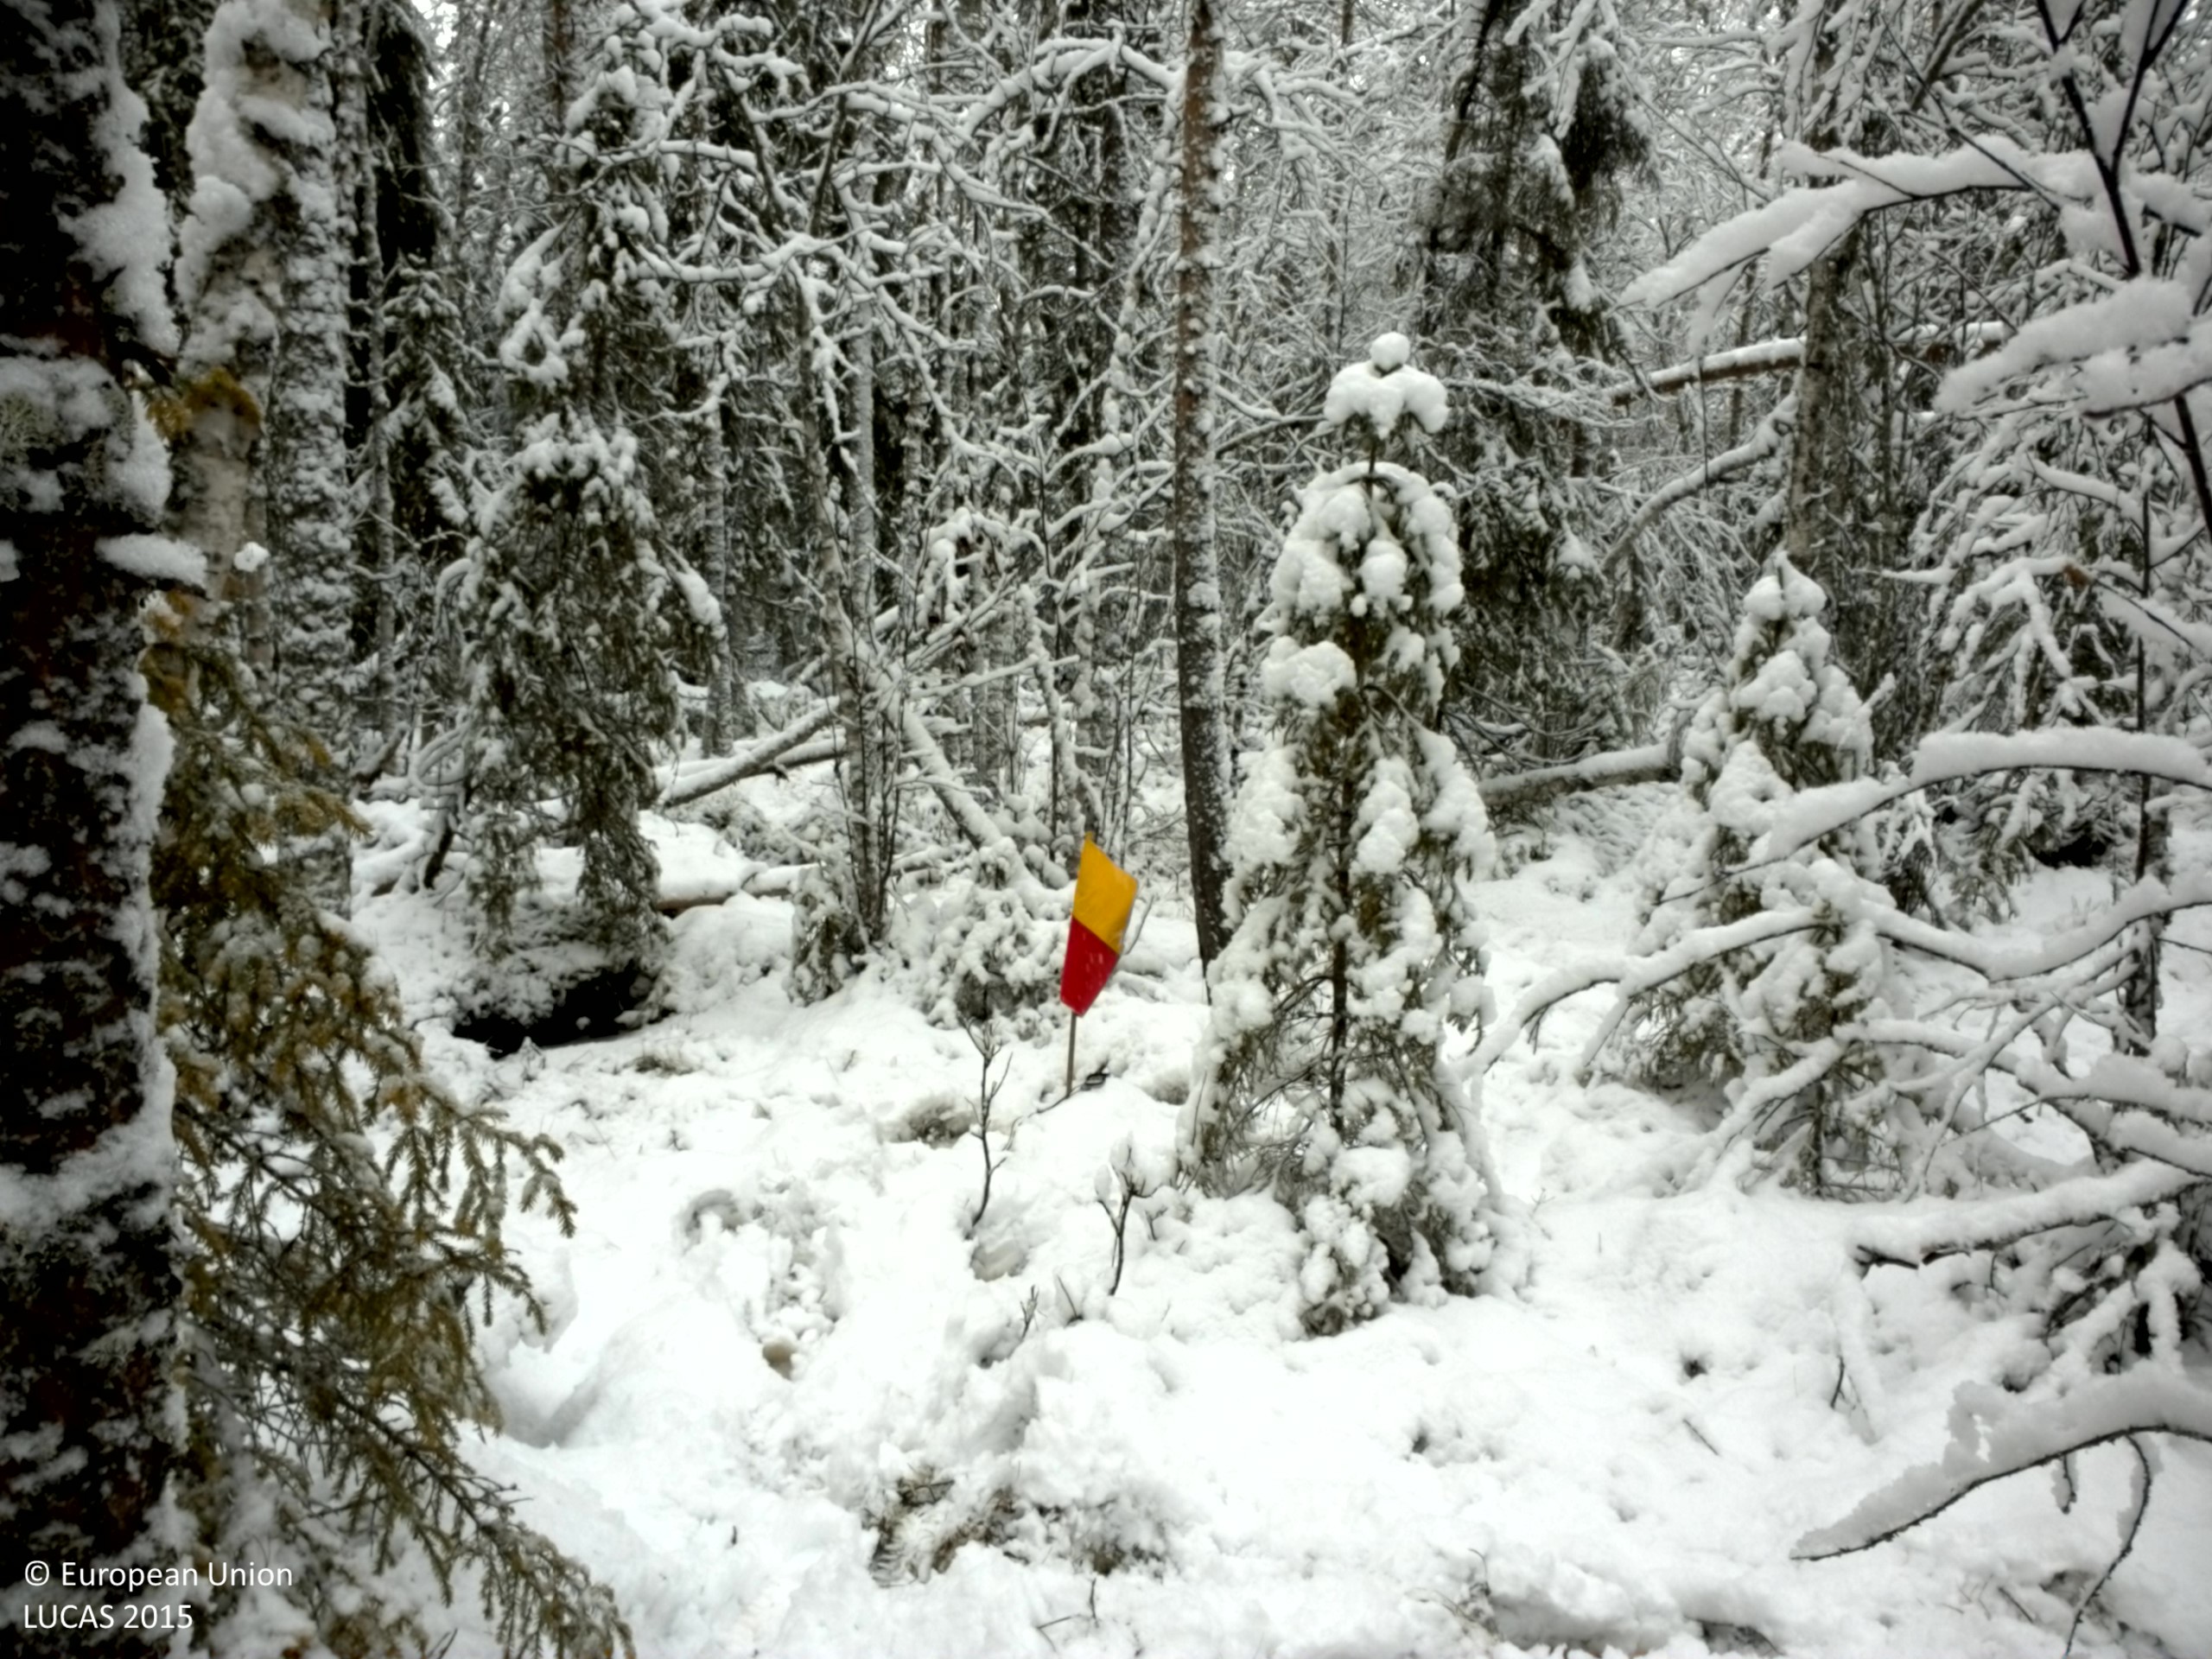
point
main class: Woodland
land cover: Other mixed woodland
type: boreal forest
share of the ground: 50 - 75 %
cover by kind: coniferous forest trees 45 %, shrubs 25 %, broadleaved forest trees 15 %, lichens and mosses 10 %, herbaceous plants 5 %
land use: Forestry
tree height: > 5 m
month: November
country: SE
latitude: 63.7595
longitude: 15.5081
